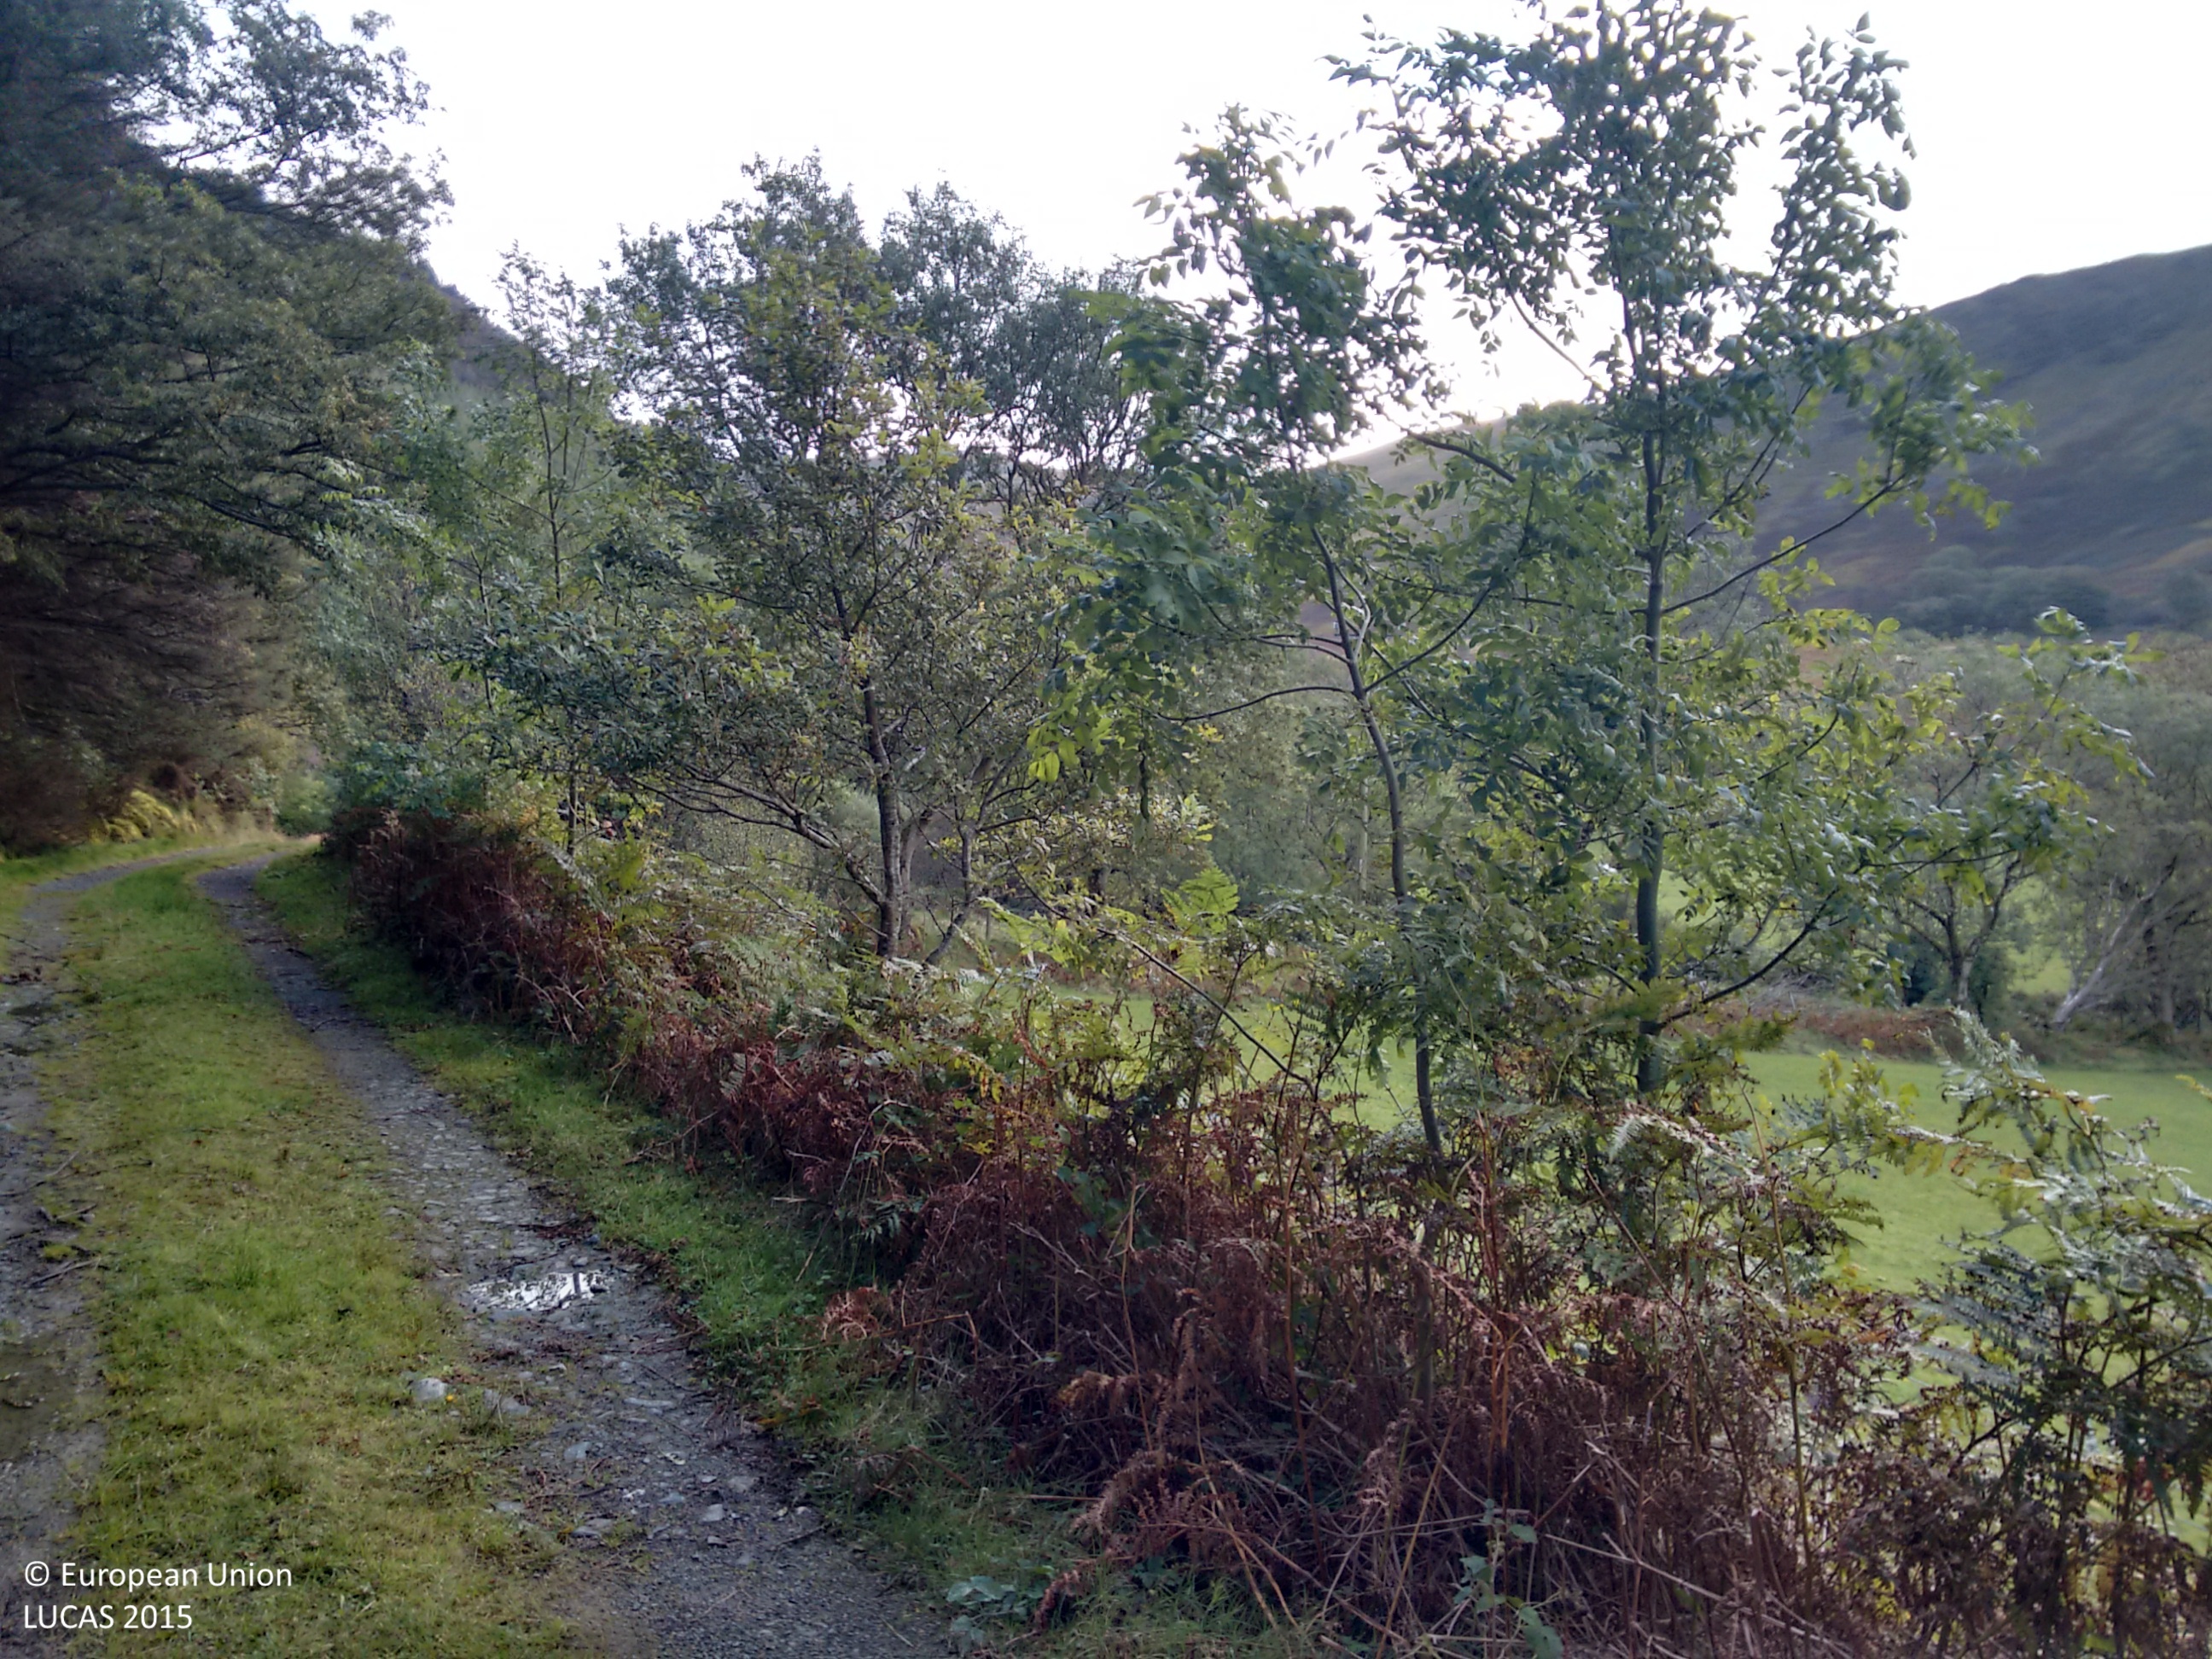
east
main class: Shrubland
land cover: Shrubland without tree cover
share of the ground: > 75 %
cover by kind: shrubs 100 %
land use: Semi-natural and natural areas not in use
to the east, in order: Shrubland without tree cover
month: October
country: GB
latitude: 52.4689
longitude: -3.8851
